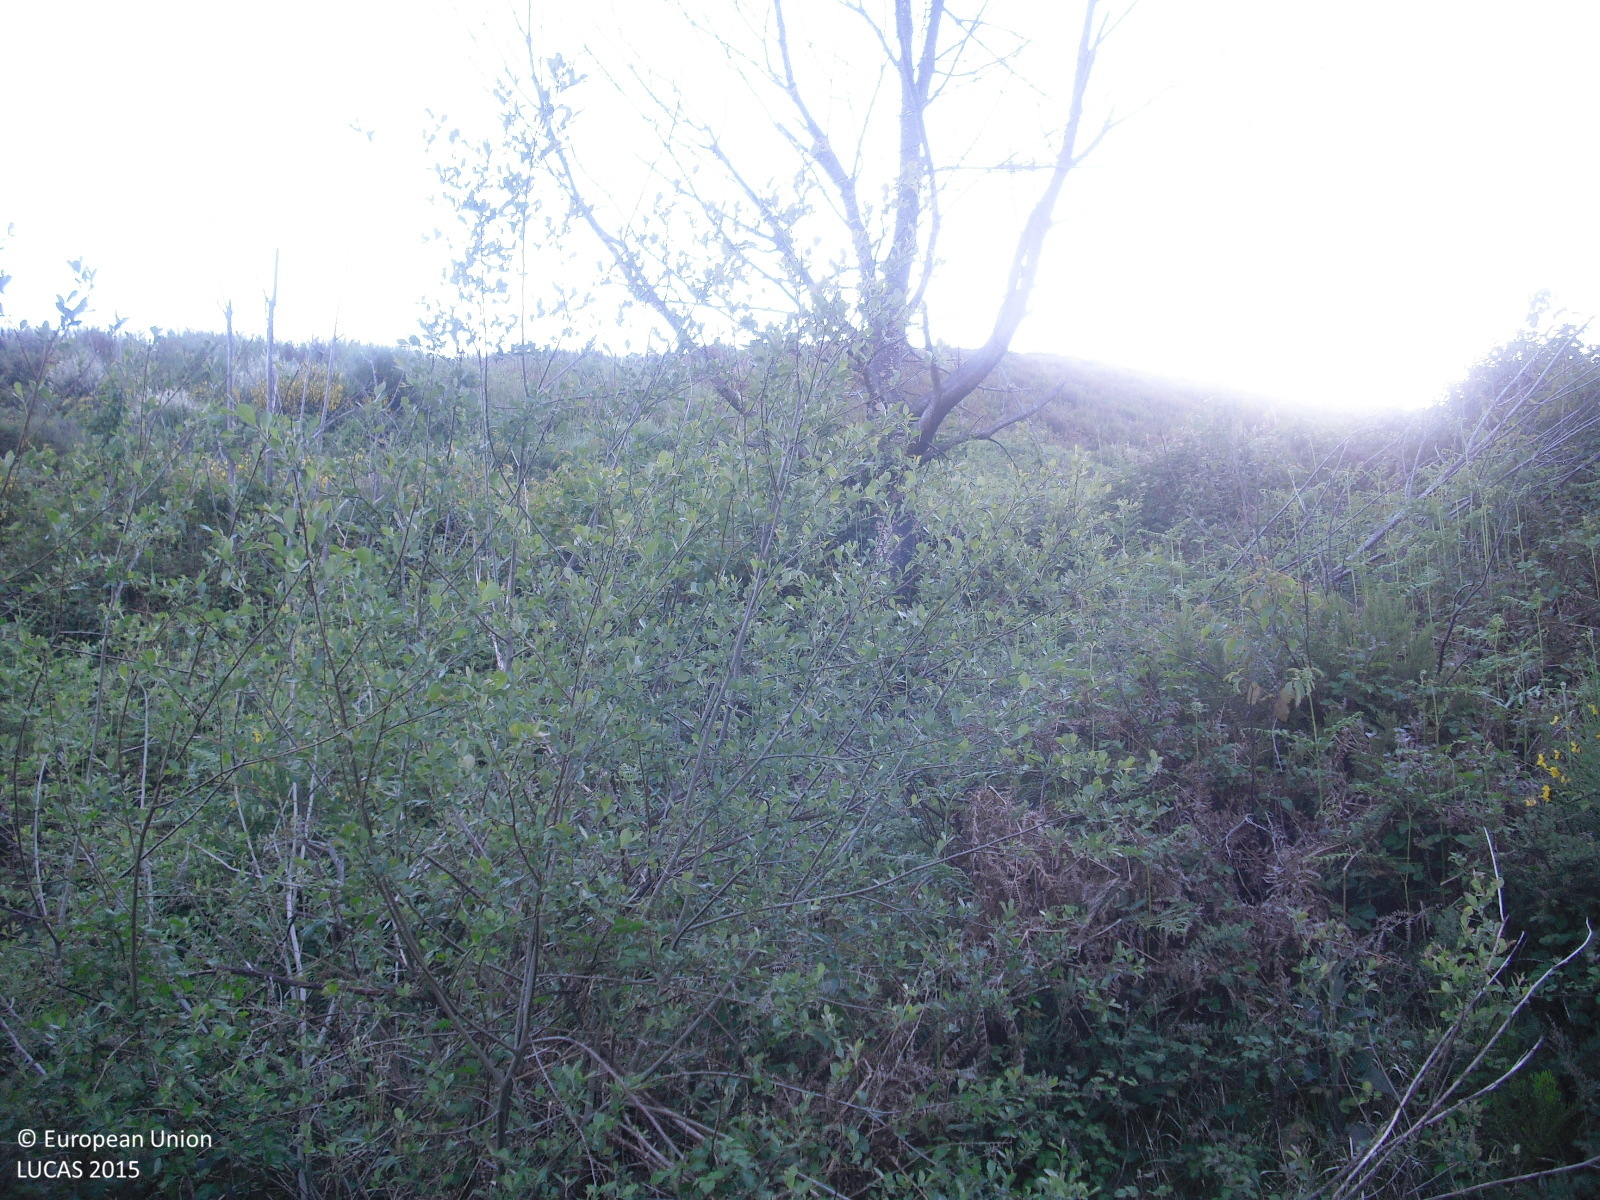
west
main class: Shrubland
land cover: Shrubland with sparse tree cover
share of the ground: > 75 %
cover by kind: shrubs 80 %, herbaceous plants 15 %, broadleaved forest trees 5 %
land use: Forestry
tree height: < 5 m
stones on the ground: 25 - 50 %
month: May
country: ES
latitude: 42.0249
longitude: -7.3663
